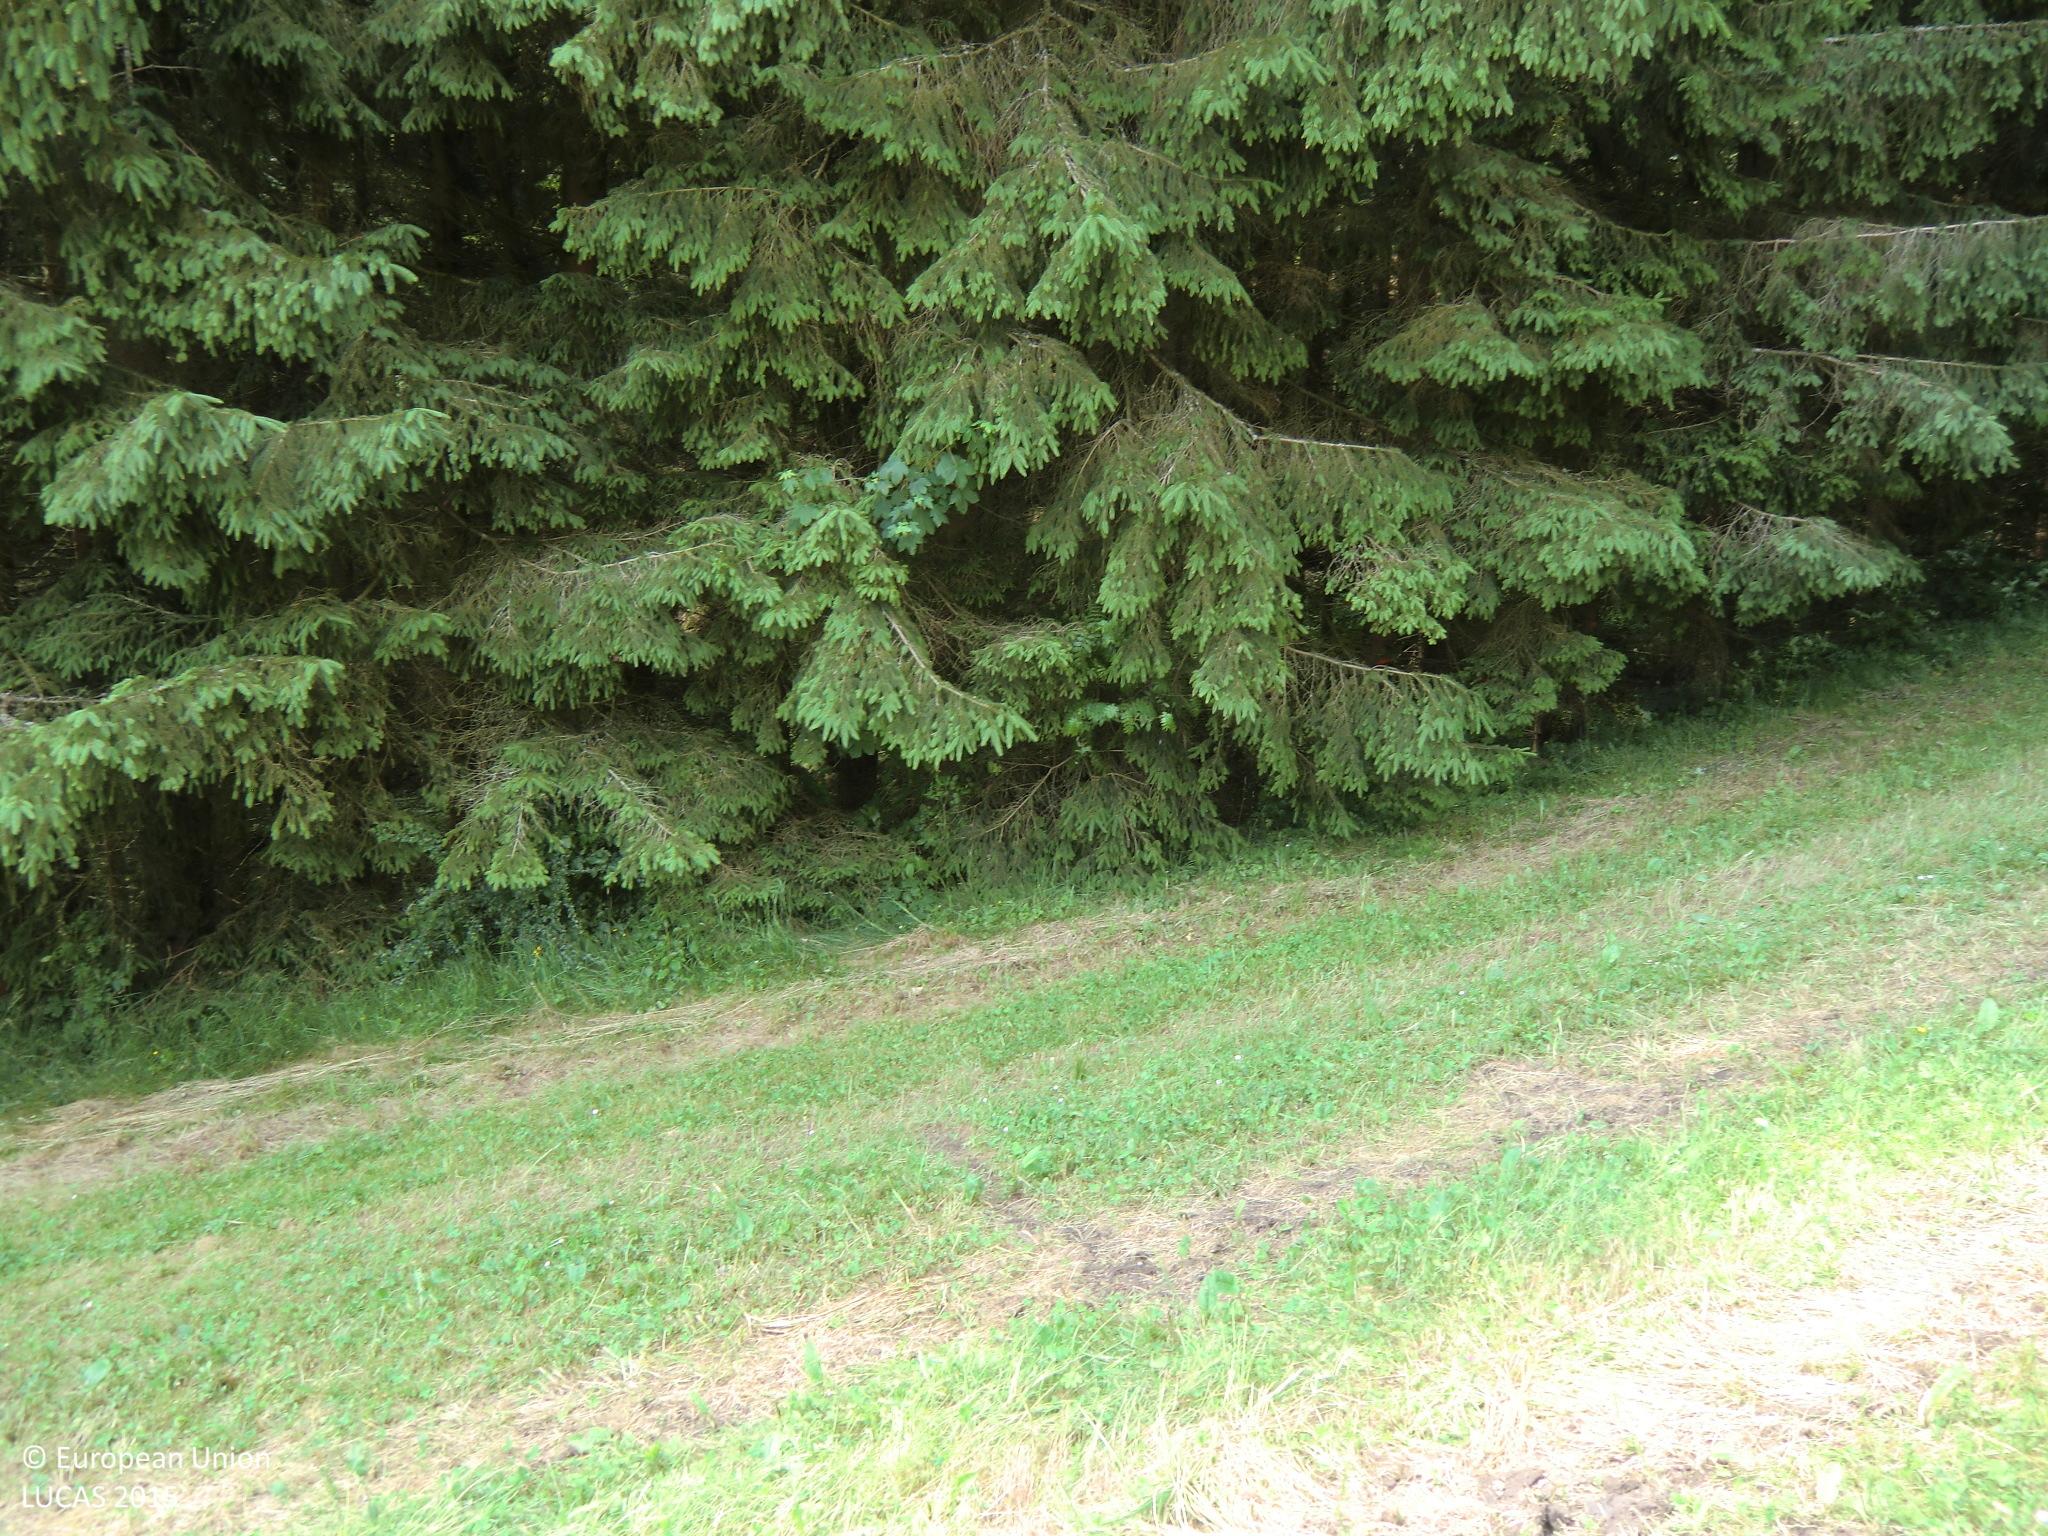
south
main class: Grassland
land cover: Grassland without tree/shrub cover
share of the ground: > 75 %
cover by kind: herbaceous plants 90 %, consolidated bare surface 10 %
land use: Agriculture (excluding fallow land and kitchen gardens)
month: June
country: AT
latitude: 48.4447
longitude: 14.7733
